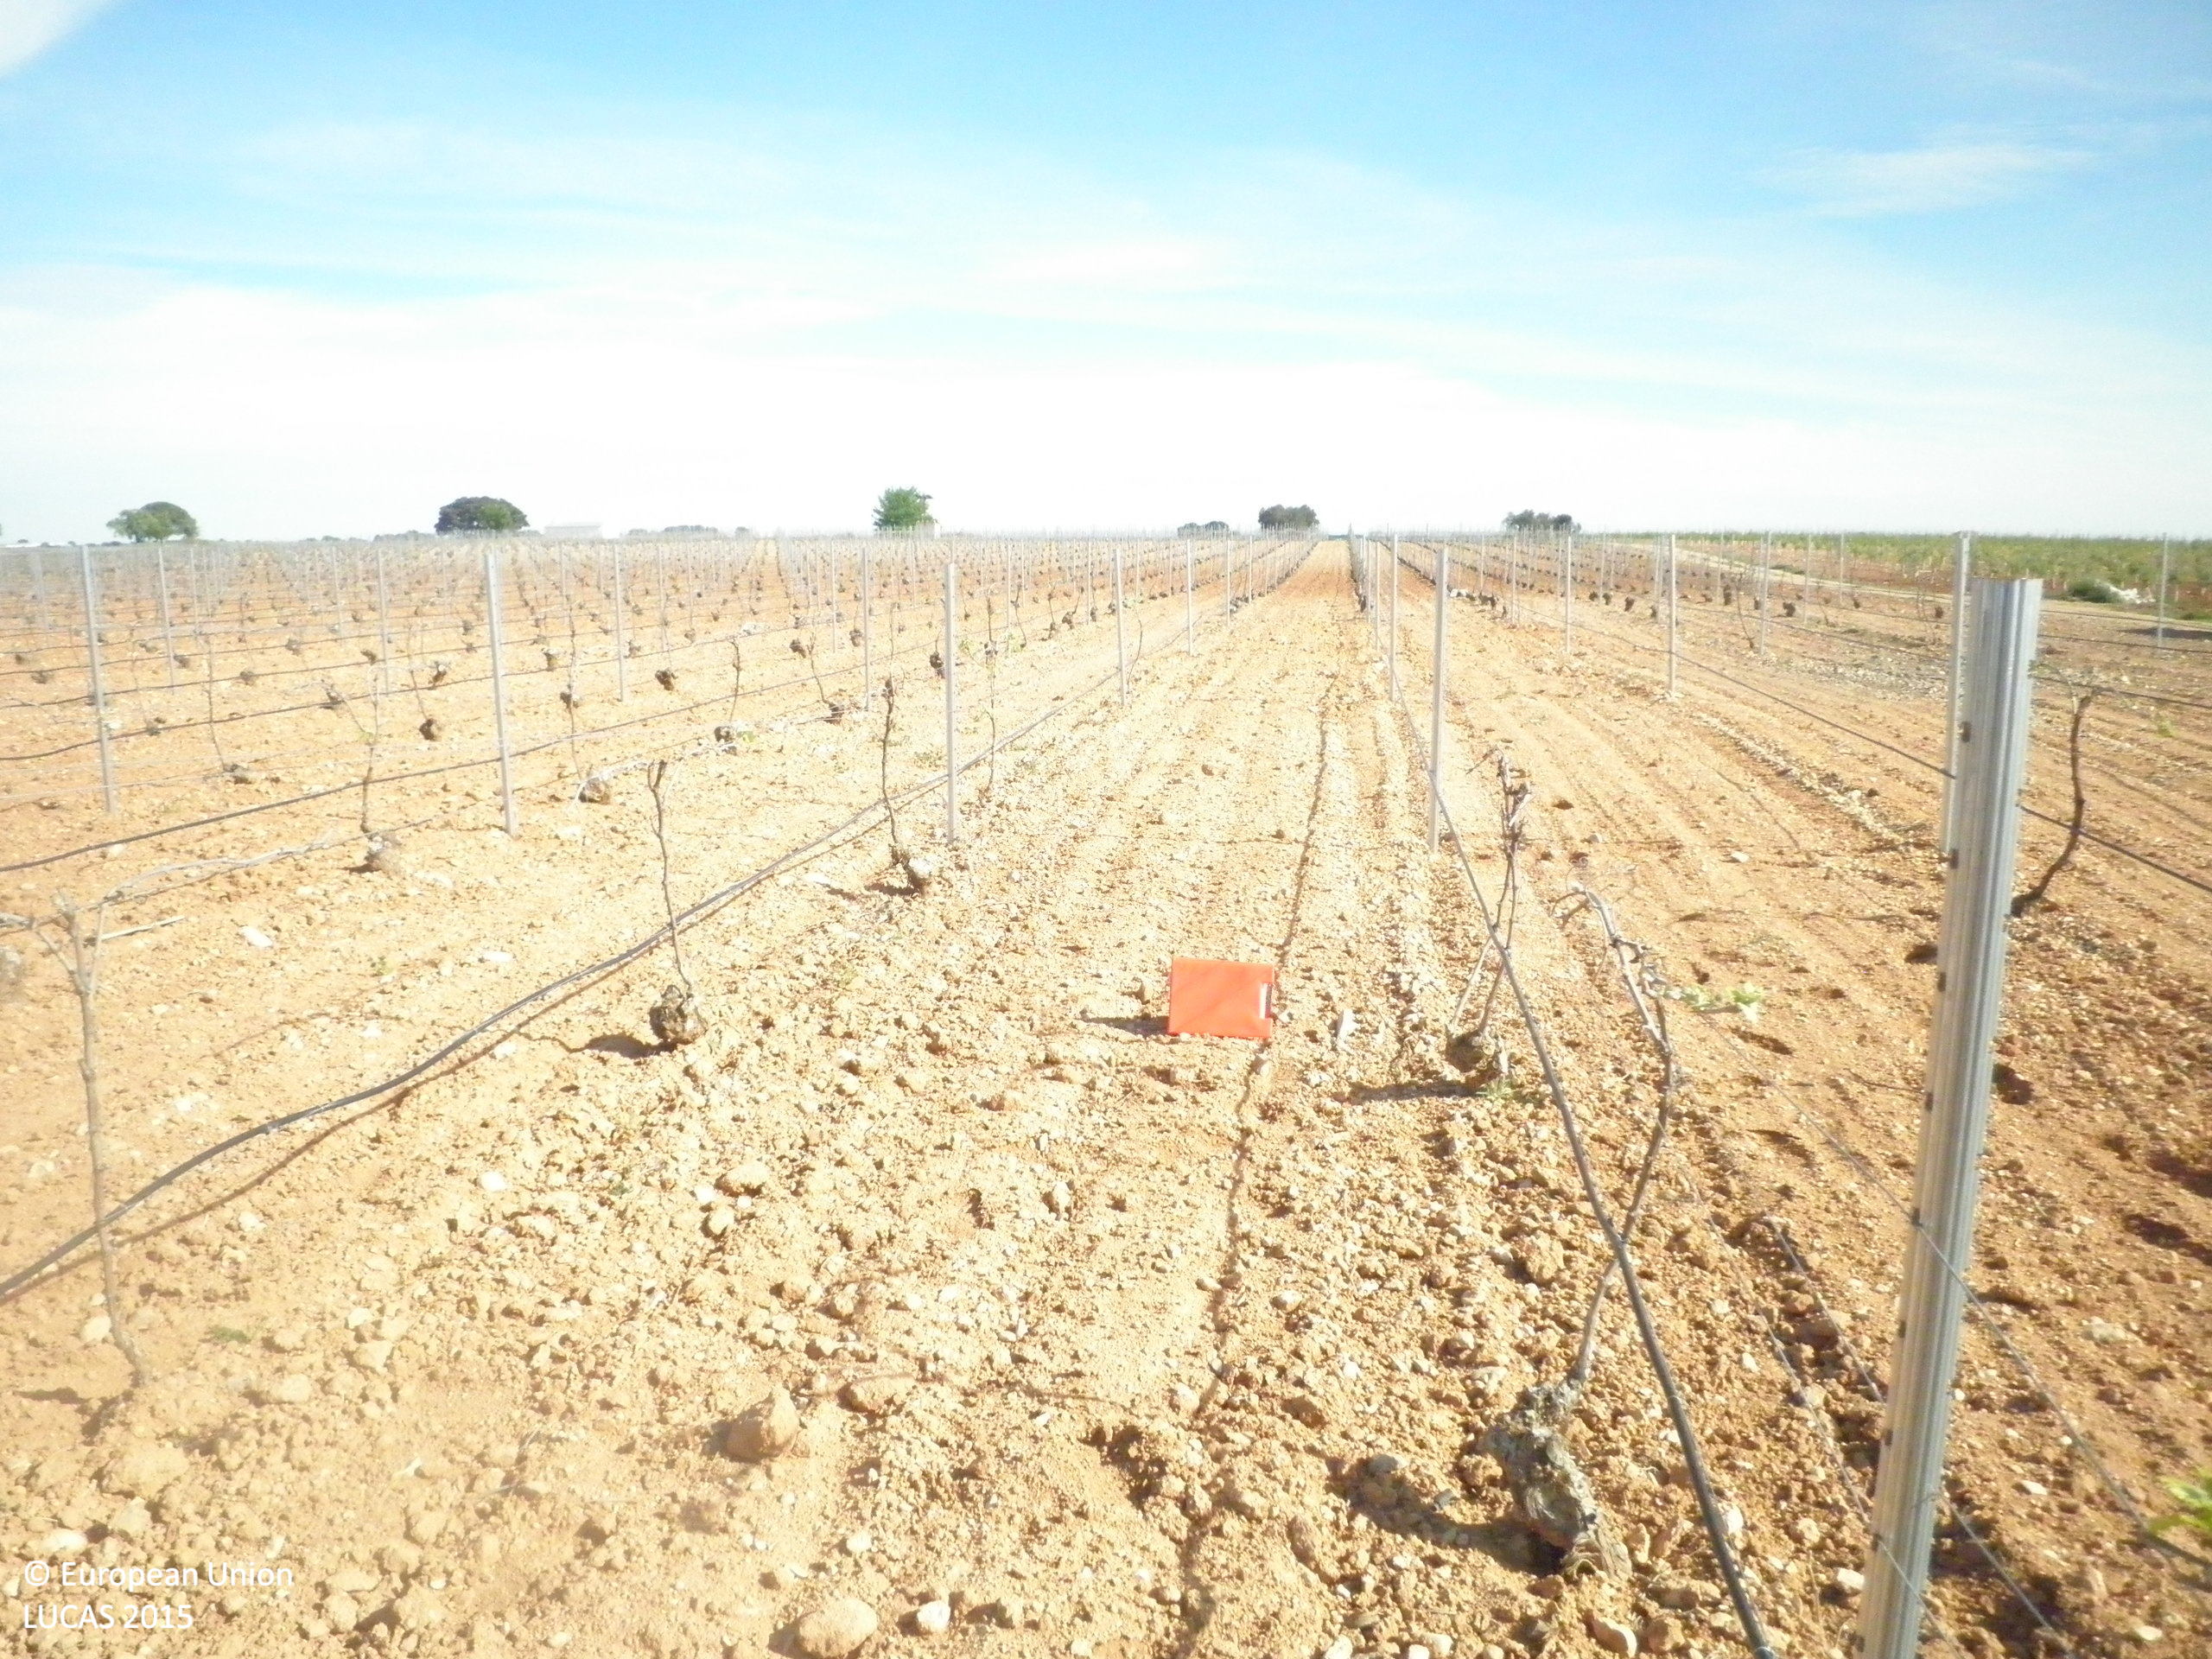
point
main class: Cropland
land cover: Vineyards
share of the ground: < 10 %
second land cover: Other bare soil
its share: > 75 %
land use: Agriculture (excluding fallow land and kitchen gardens)
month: April
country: ES
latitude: 39.3654
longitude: -2.6983
